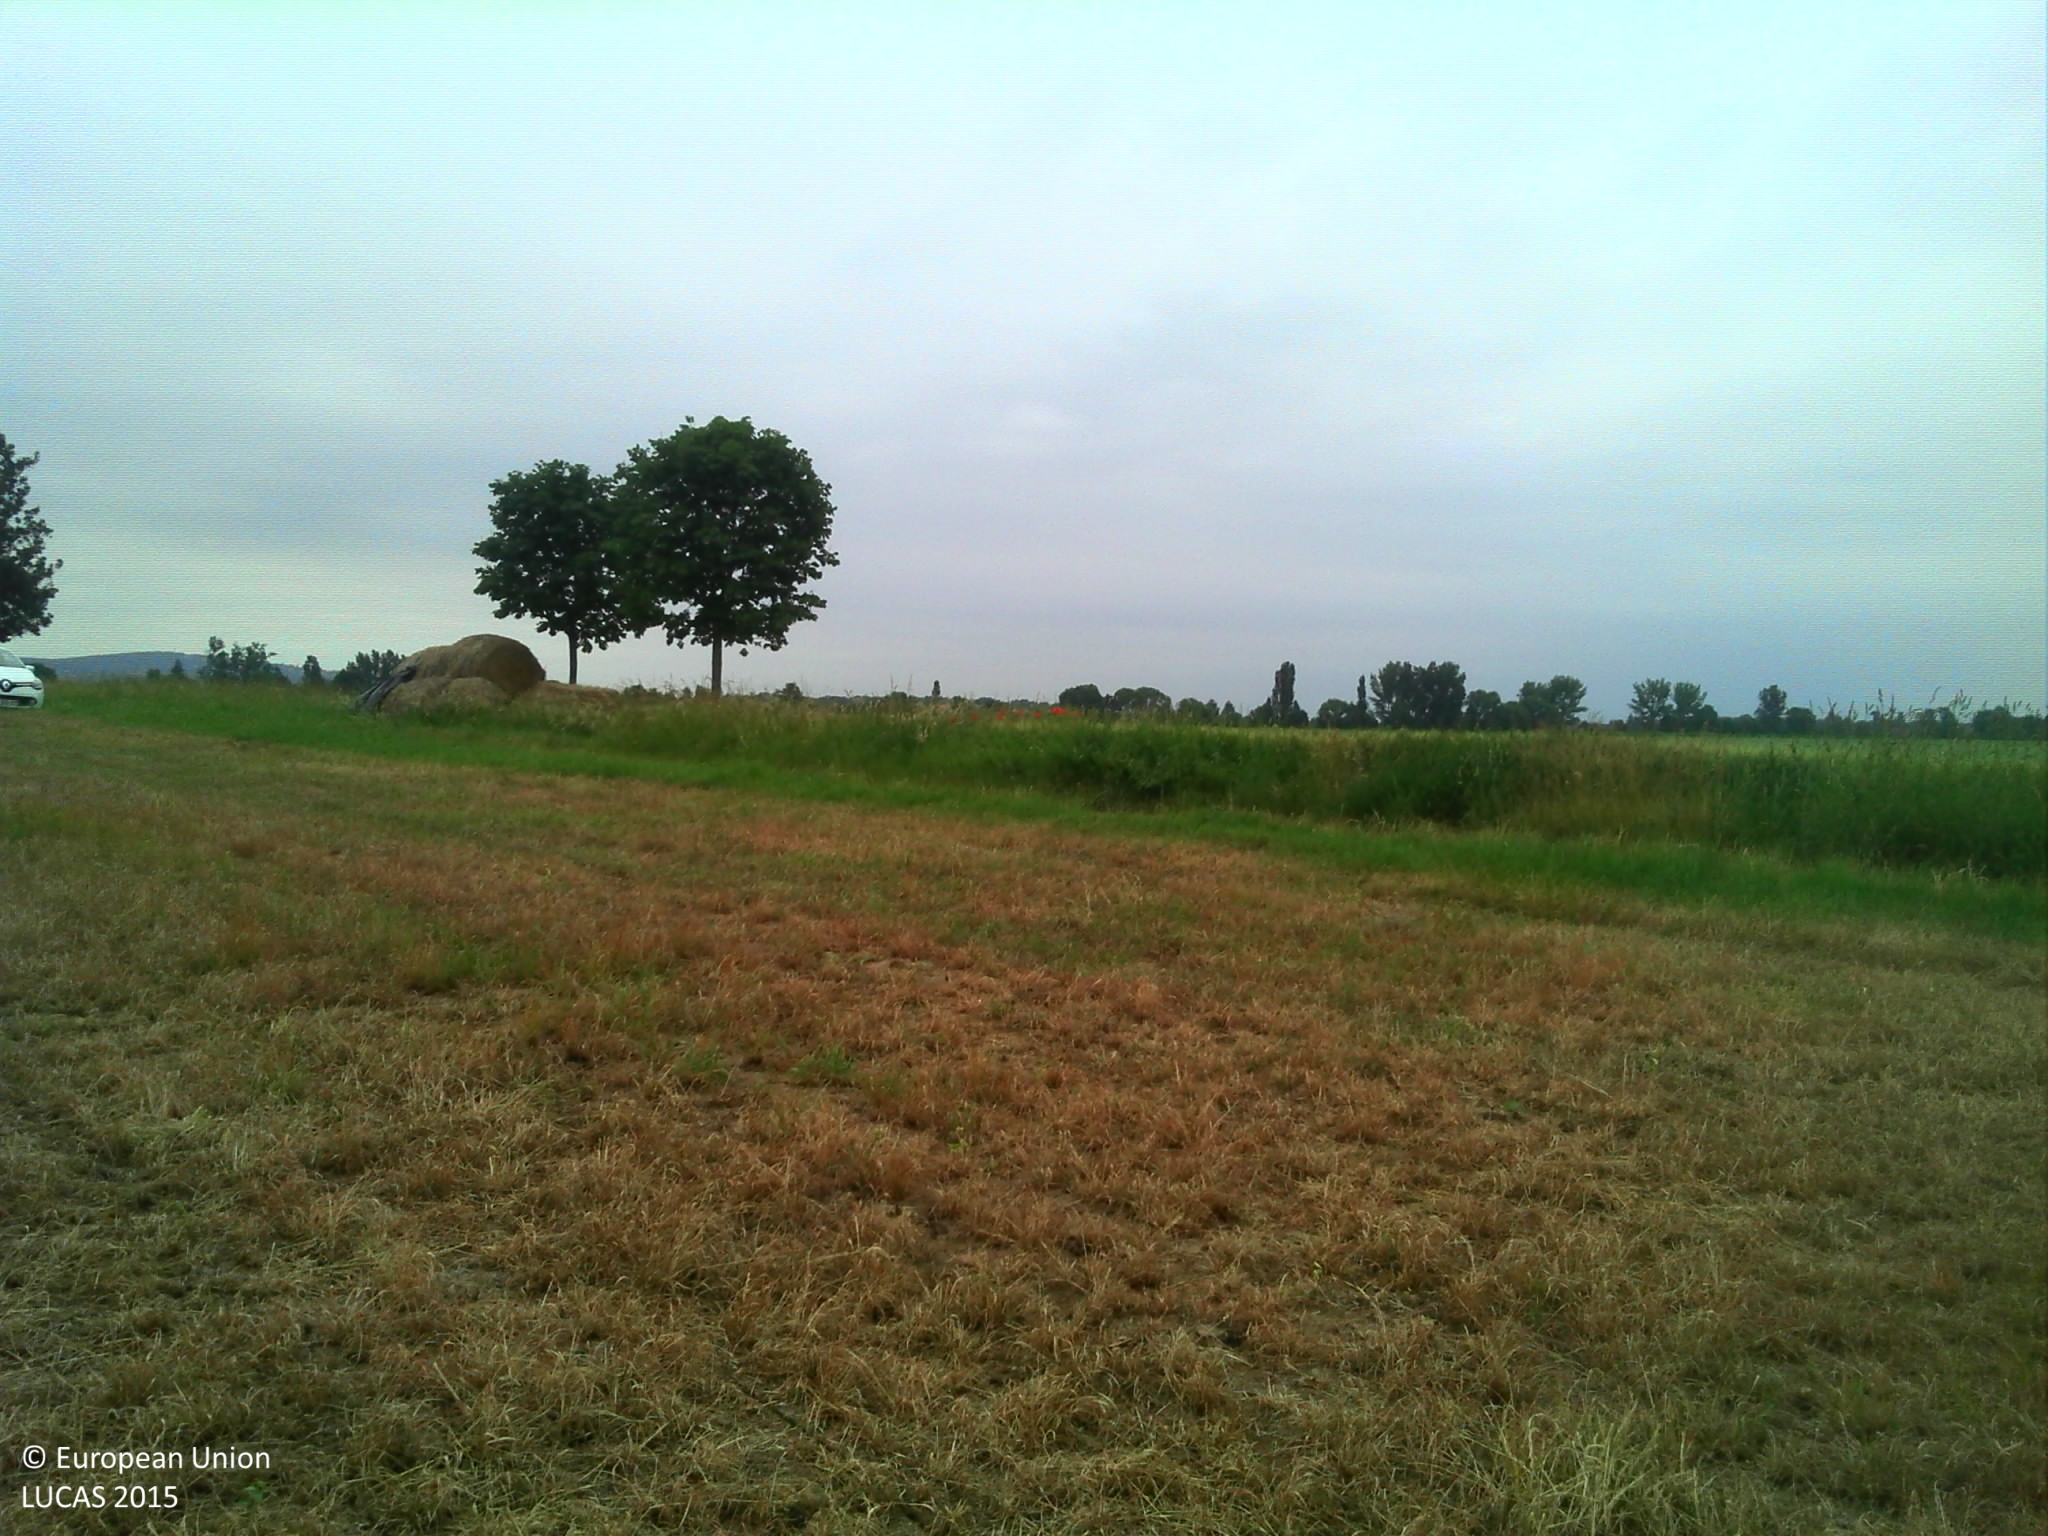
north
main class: Grassland
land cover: Grassland without tree/shrub cover
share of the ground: > 75 %
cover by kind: herbaceous plants 100 %
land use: Agriculture (excluding fallow land and kitchen gardens)
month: June
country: FR
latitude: 48.4113
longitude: 7.5015
